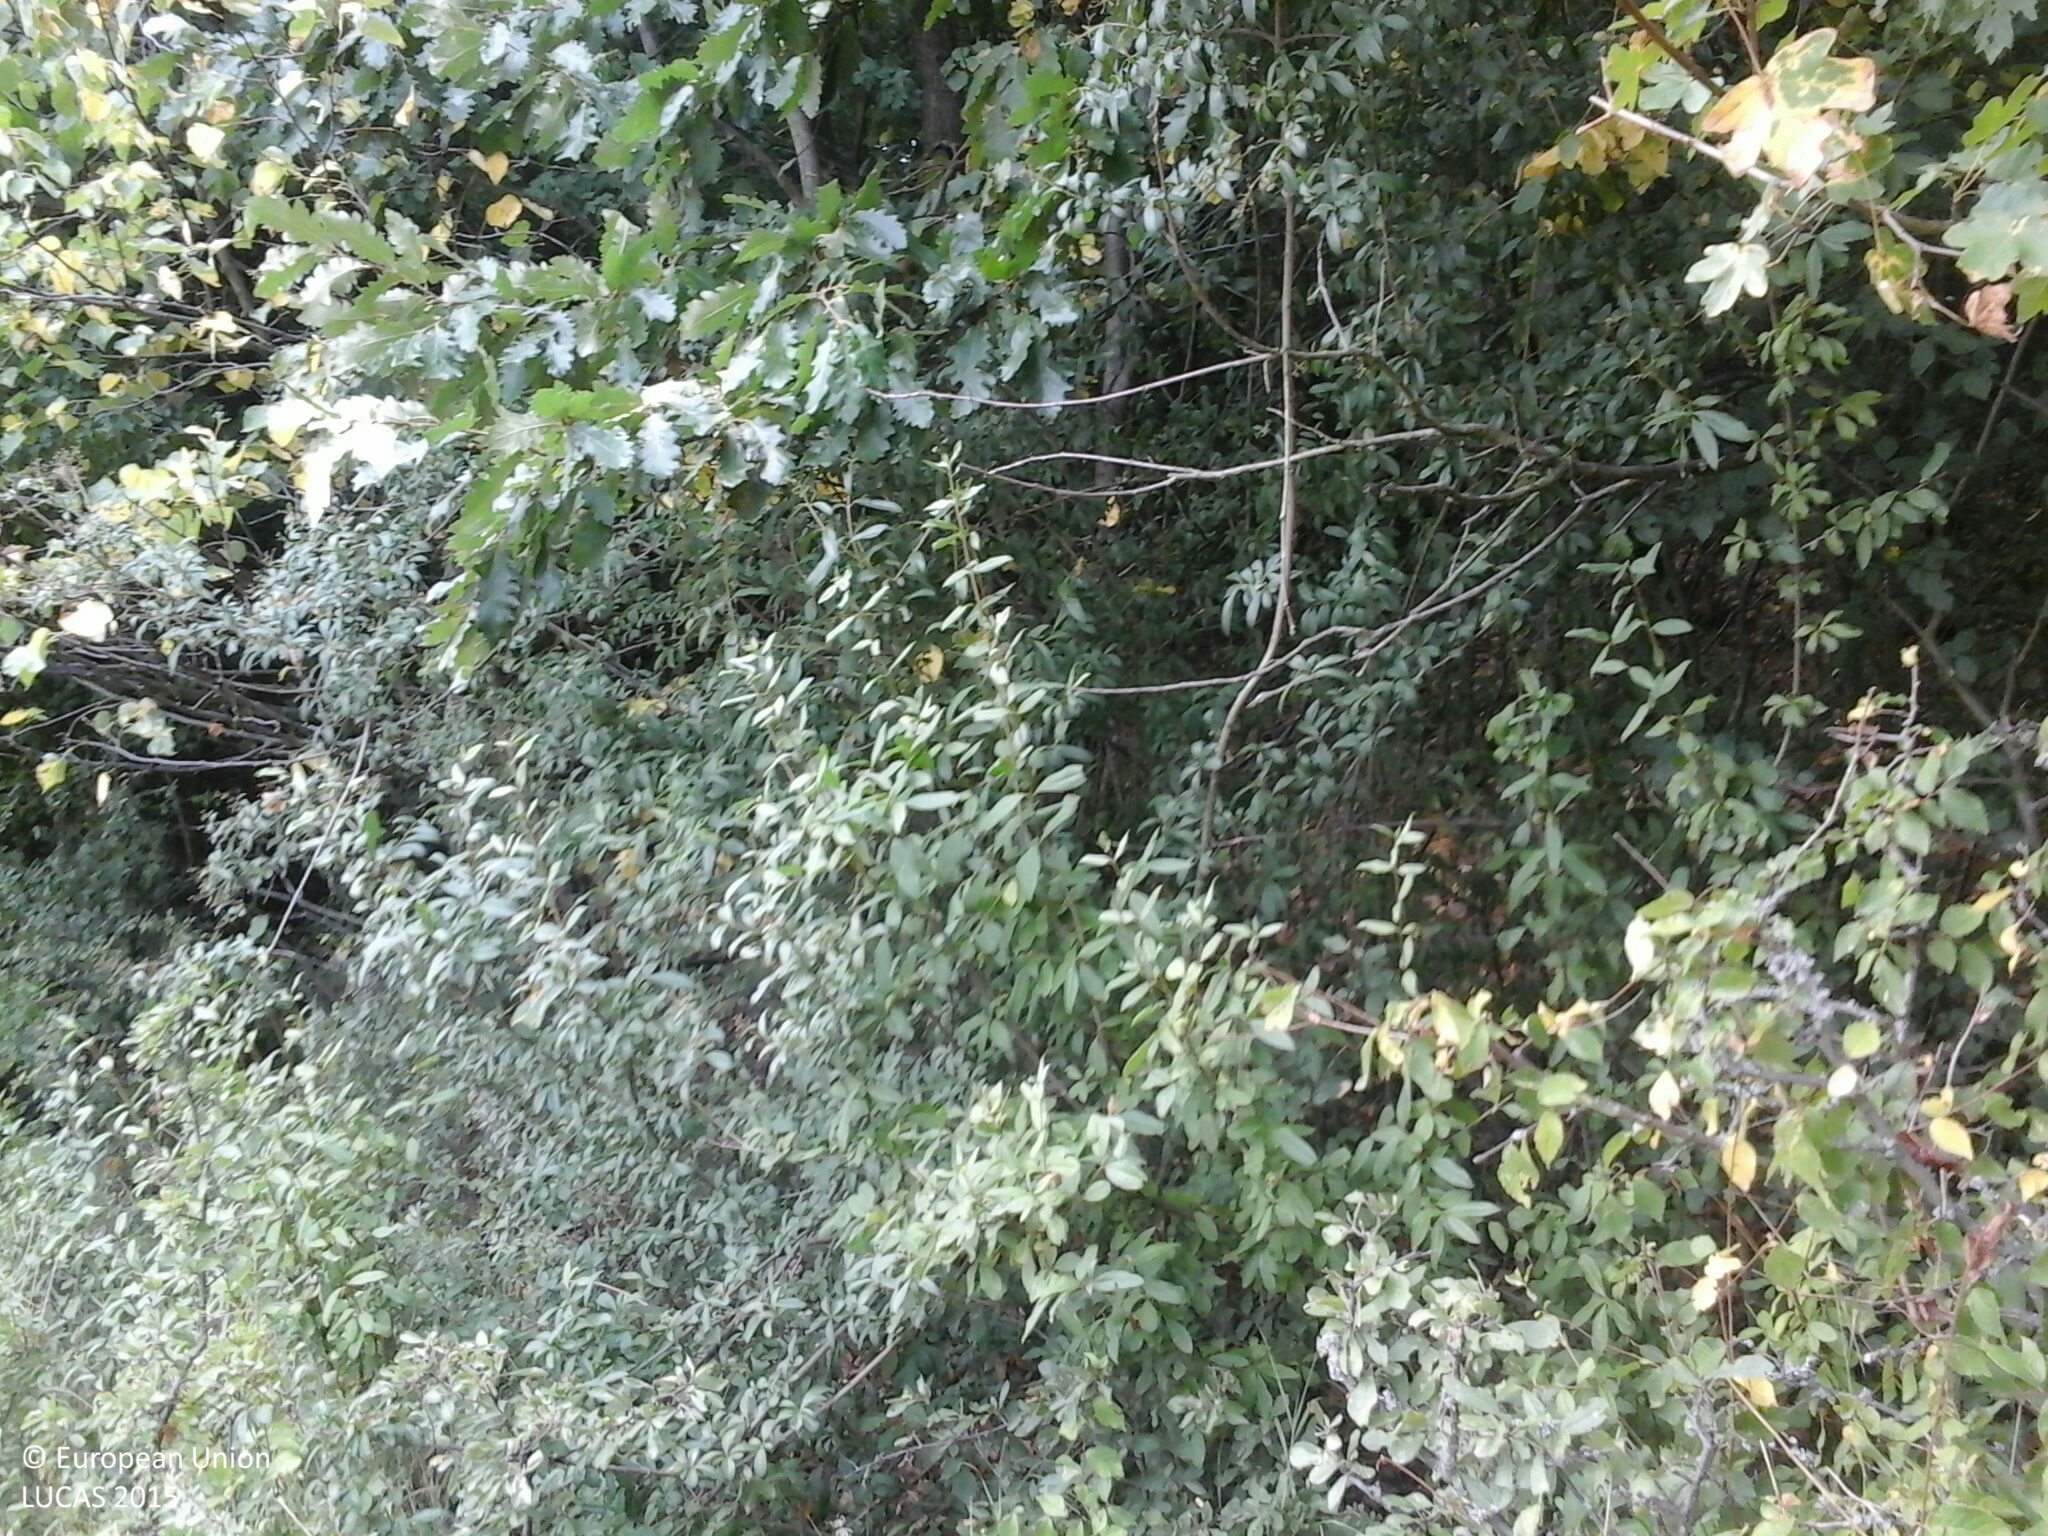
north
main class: Woodland
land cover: Broadleaved woodland
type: mesophytic deciduous forest
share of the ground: > 75 %
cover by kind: broadleaved forest trees 100 %
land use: Forestry
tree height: > 5 m
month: July
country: HU
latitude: 47.9184
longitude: 19.3217
